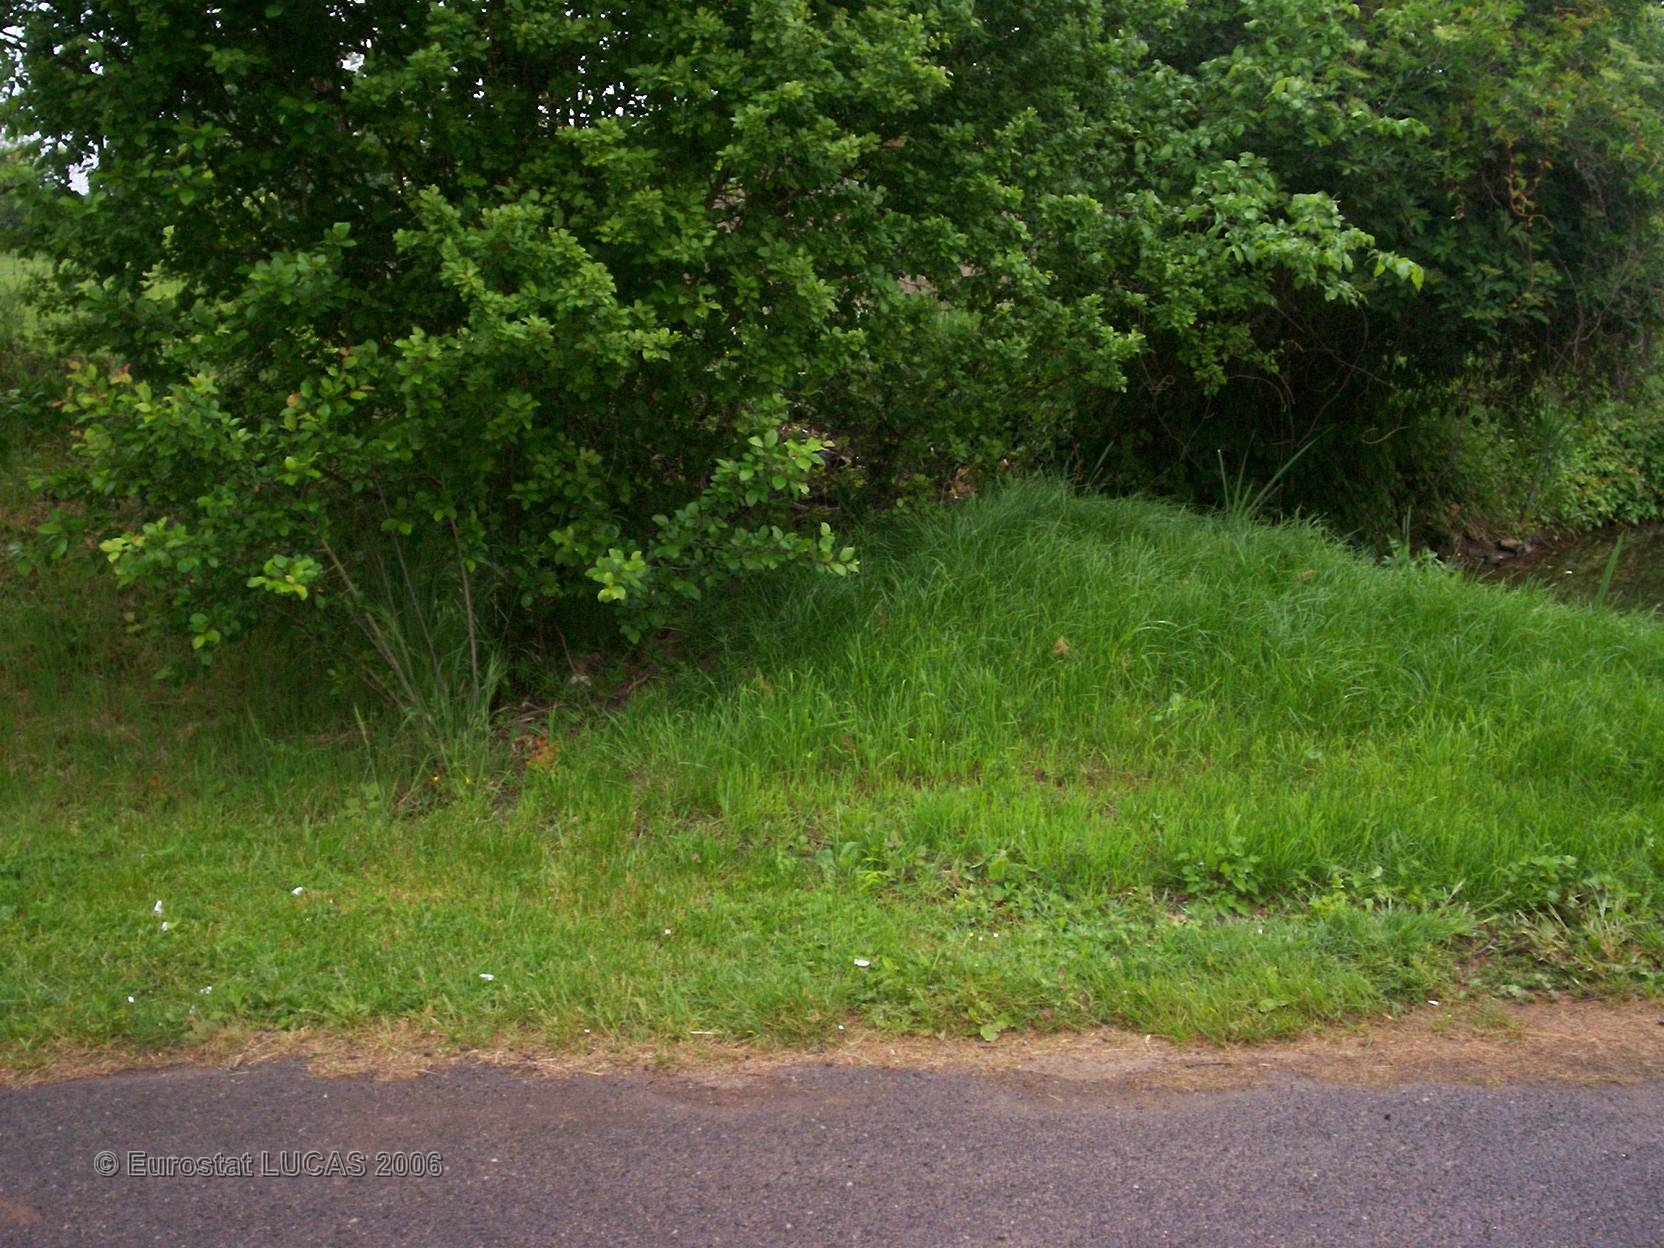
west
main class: Grassland
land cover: Grassland without tree/shrub cover
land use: Residential
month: May
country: FR
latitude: 46.5239
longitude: 0.4791
